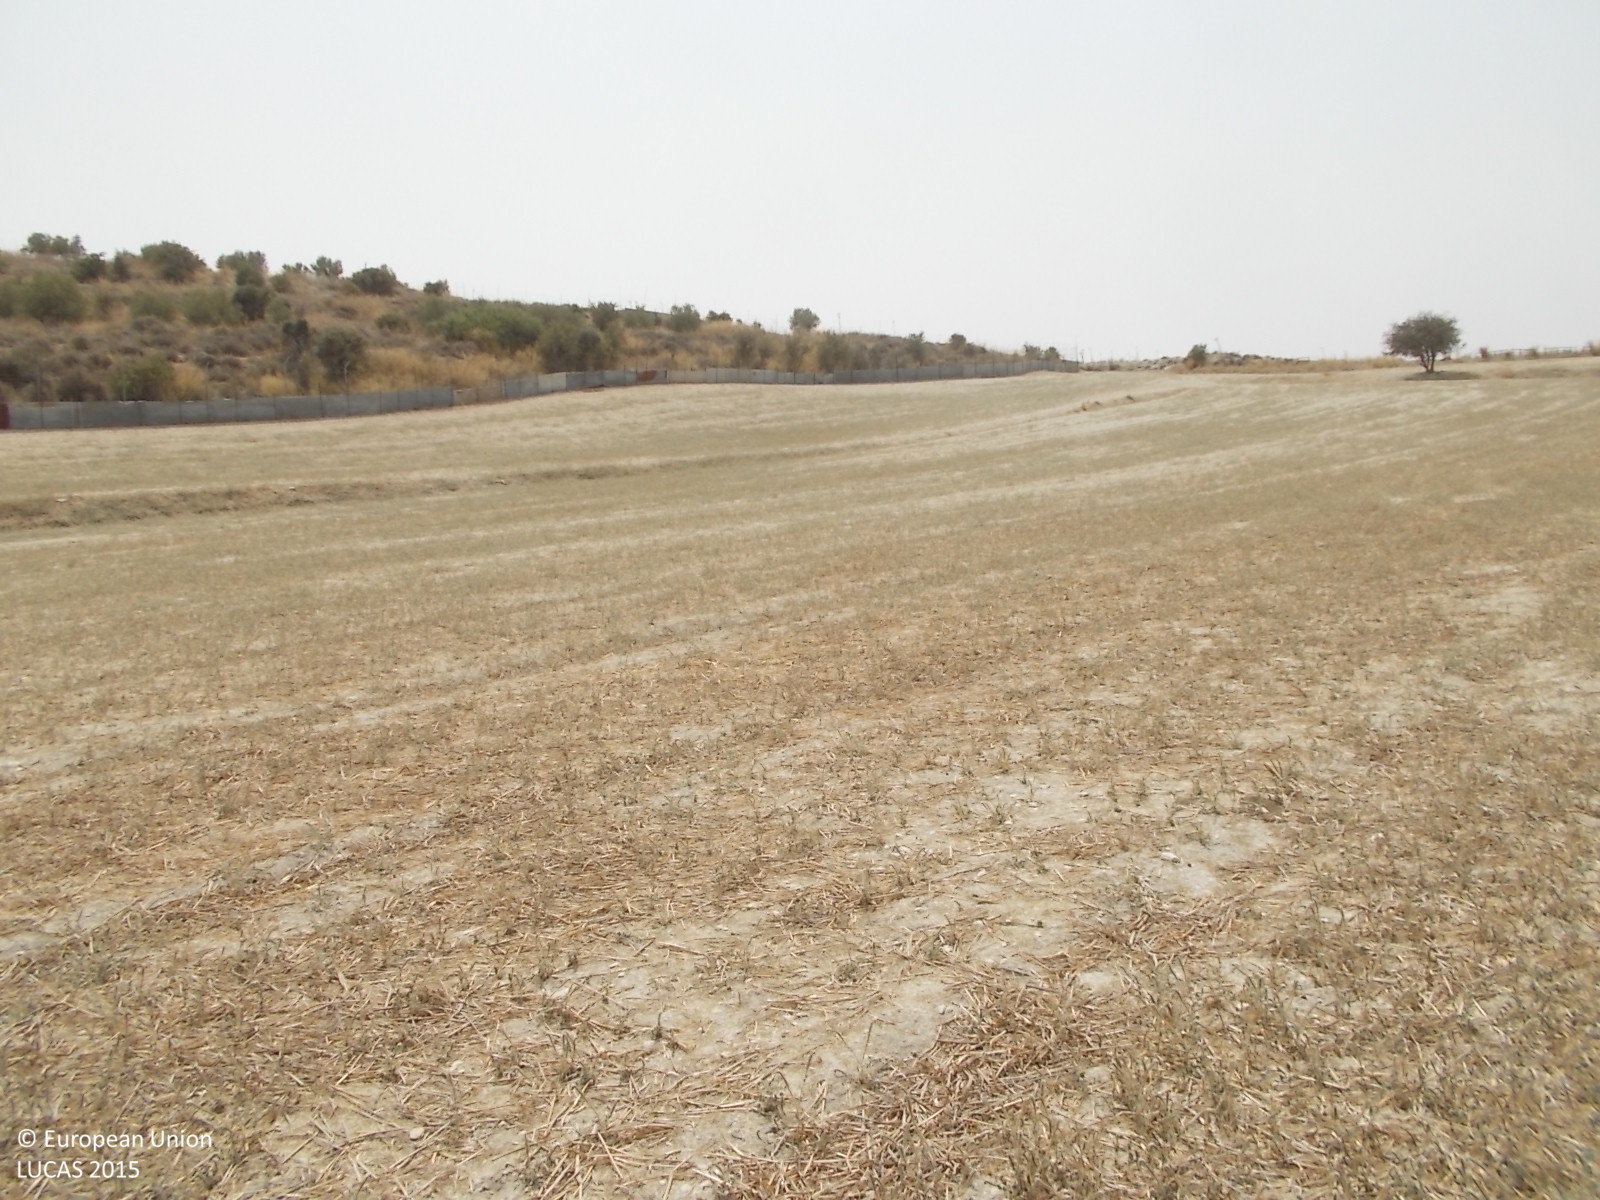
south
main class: Cropland
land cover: Mixed cereals for fodder
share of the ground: > 75 %
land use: Agriculture (excluding fallow land and kitchen gardens)
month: April
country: CY
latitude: 34.9398
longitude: 33.5247
